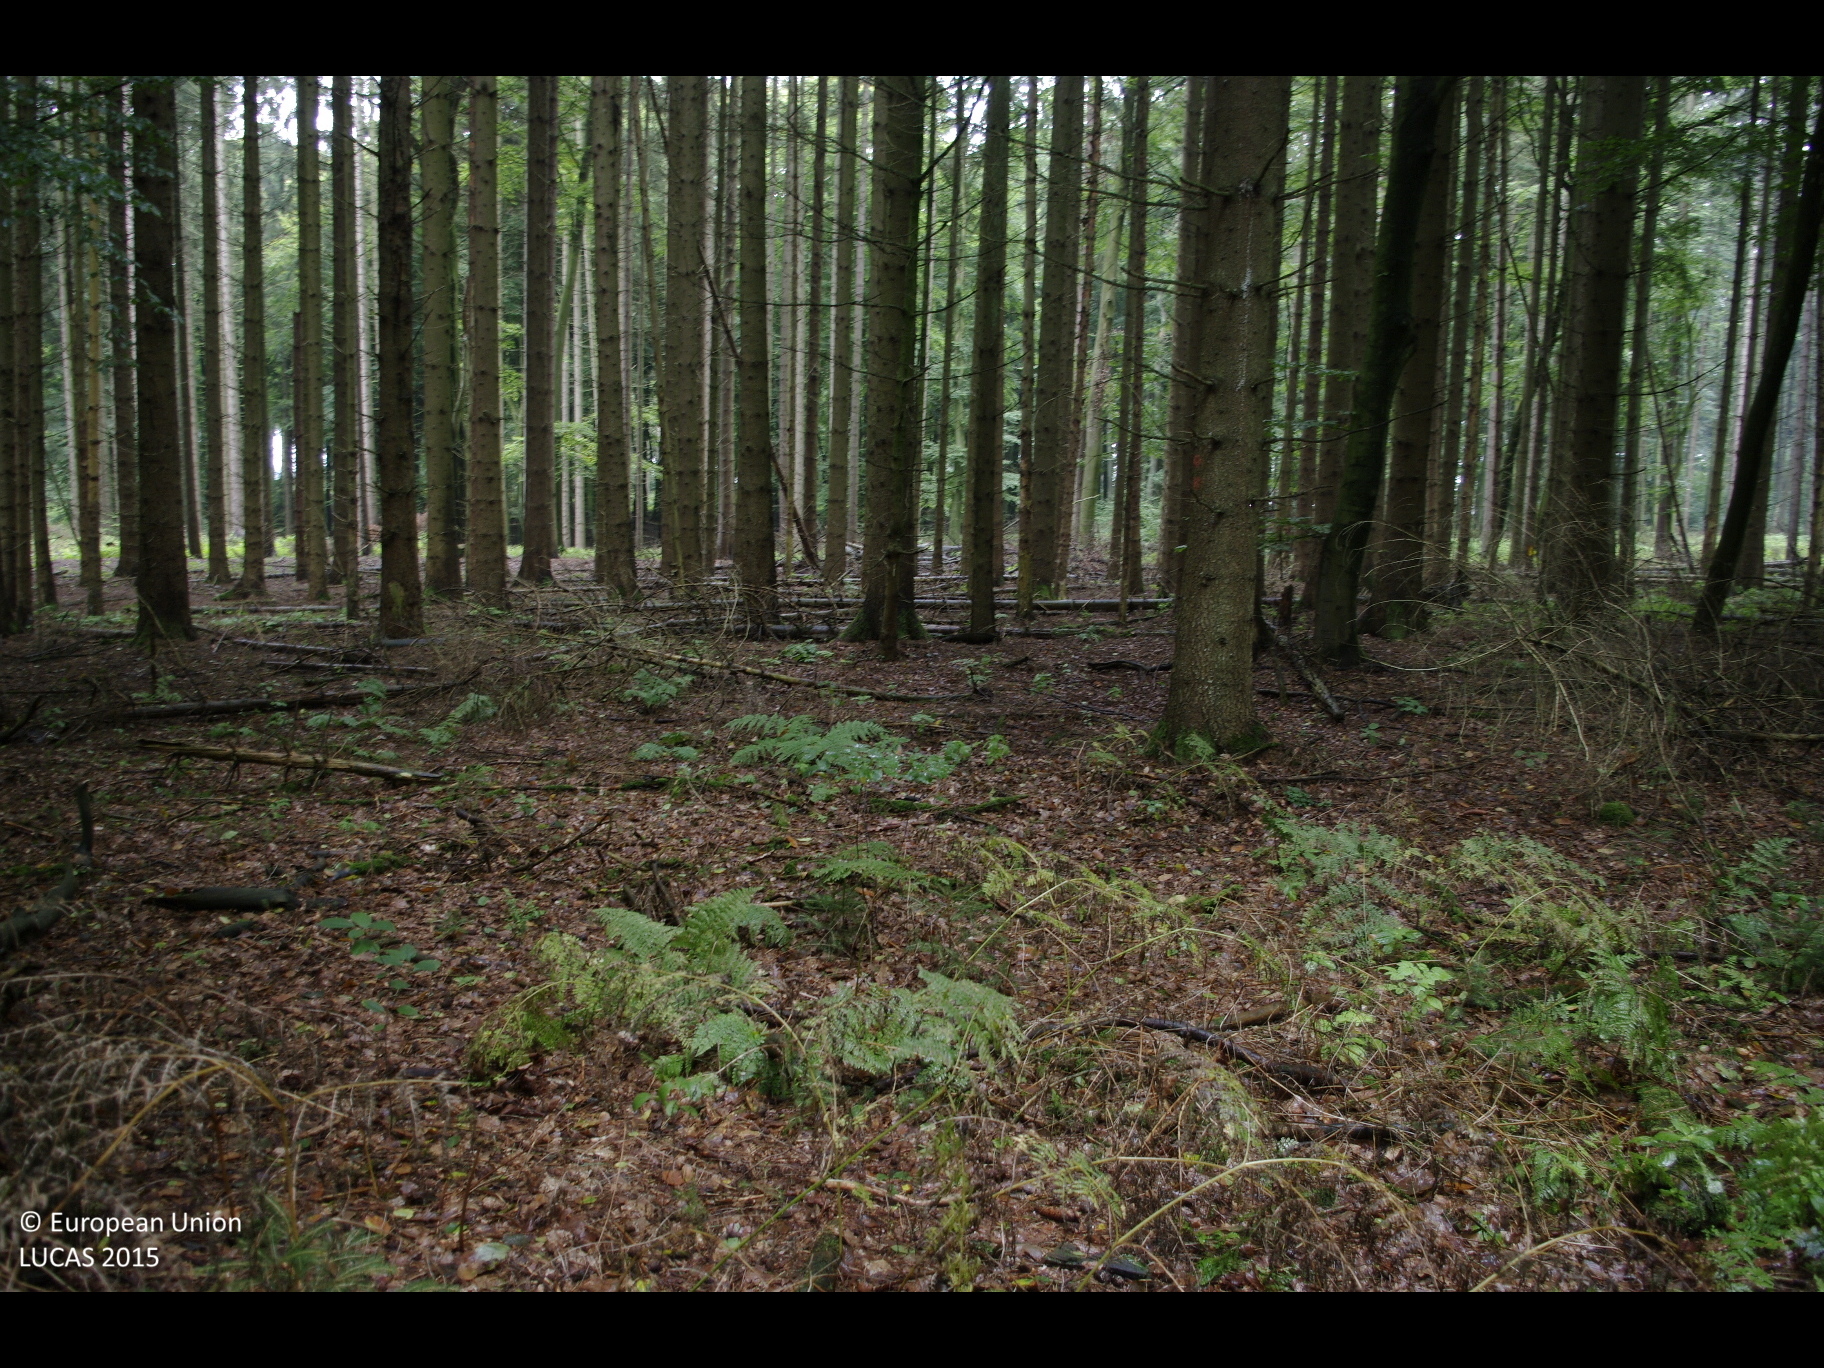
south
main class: Woodland
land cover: Pine dominated mixed woodland
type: hemiboreal forest and nemoral coniferous forest and mixed broadleaved-coniferous forest
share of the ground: > 75 %
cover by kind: coniferous forest trees 50 %, broadleaved forest trees 40 %, herbaceous plants 10 %
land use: Forestry
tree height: > 5 m
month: September
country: DE
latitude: 53.3839
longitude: 9.9249
